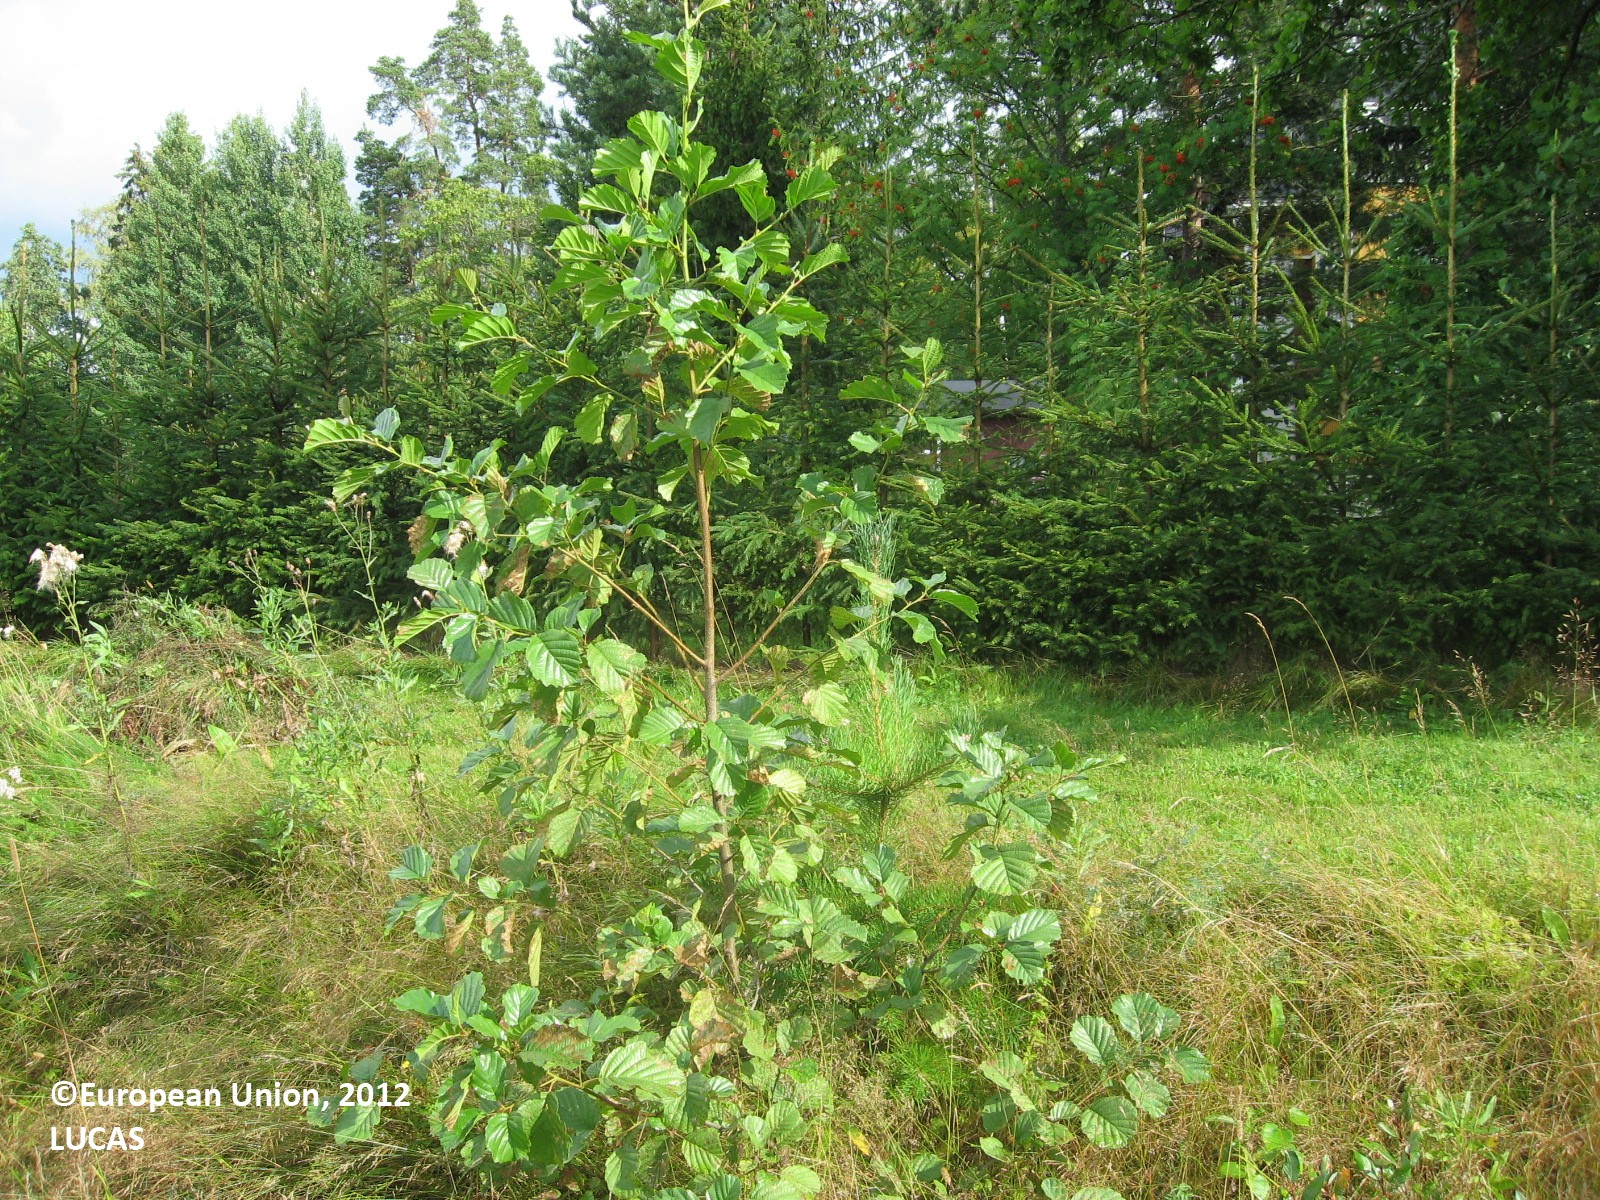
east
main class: Cropland
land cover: Other cereals
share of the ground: > 75 %
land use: Agriculture (excluding fallow land and kitchen gardens)
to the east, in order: Other cereals; Grass margins; Ditches and canals; Grass margins; Pine dominated mixed woodland; Grass margins; Ditches and canals; Grass margins; Other cereals
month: August
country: FI
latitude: 60.4477
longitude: 25.0787
